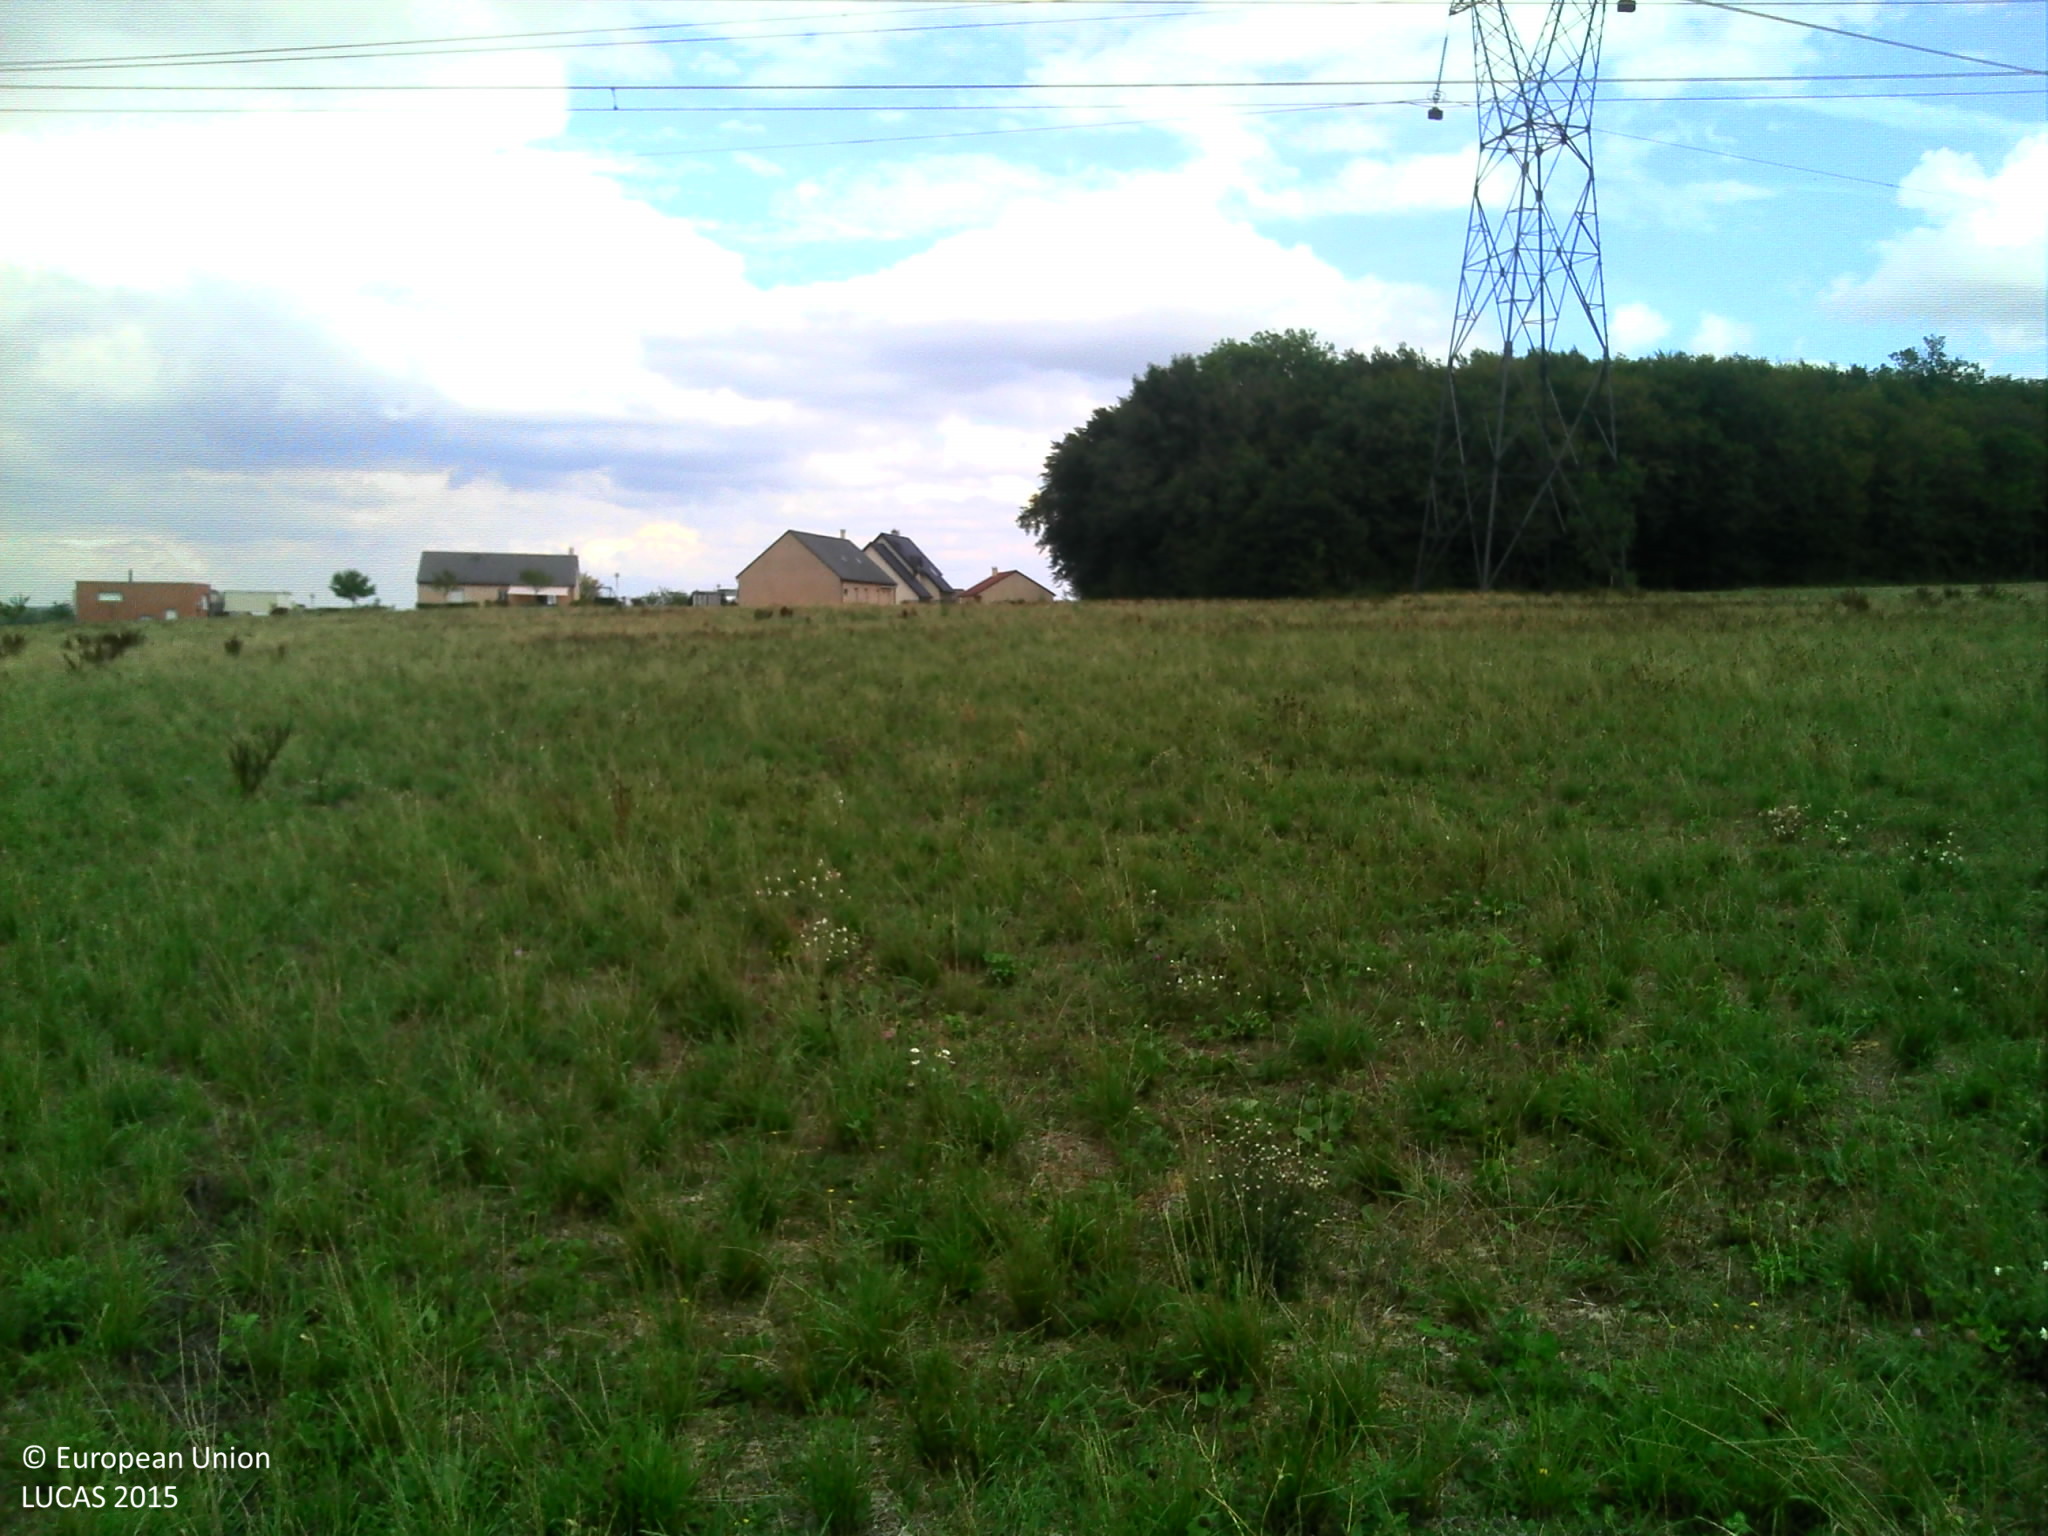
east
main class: Cropland
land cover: Temporary grasslands
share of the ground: > 75 %
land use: Agriculture (excluding fallow land and kitchen gardens)
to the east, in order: Temporary grasslands; Electric lines; Temporary grasslands; Electric lines; Temporary grasslands; Grassland without tree/shrub cover; Artificial constructions in urban areas
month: August
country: FR
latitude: 47.3023
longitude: 4.6964
